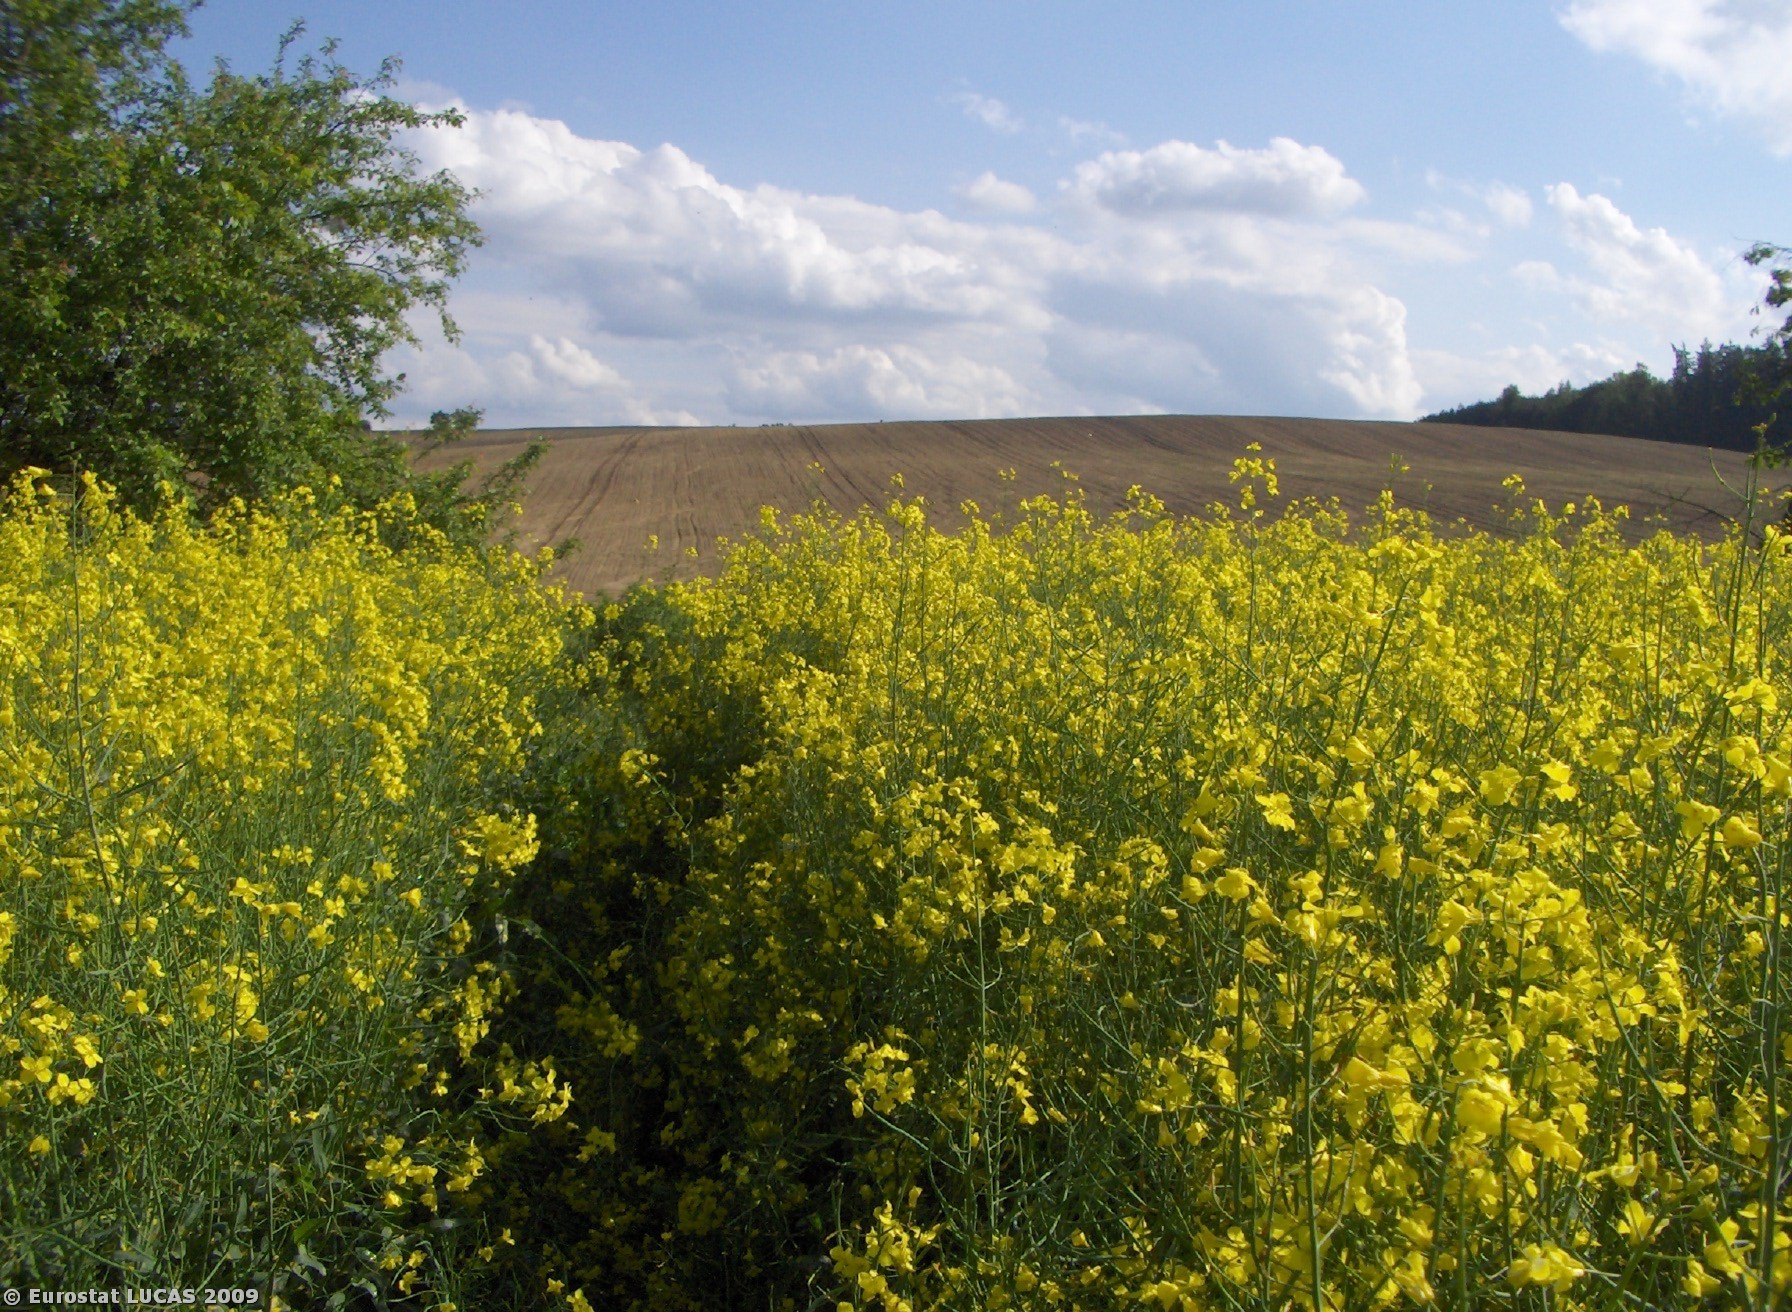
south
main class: Cropland
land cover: Rape and turnip rape
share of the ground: > 75 %
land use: Agriculture (excluding fallow land and kitchen gardens)
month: May
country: CZ
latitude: 49.3685
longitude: 14.2011
